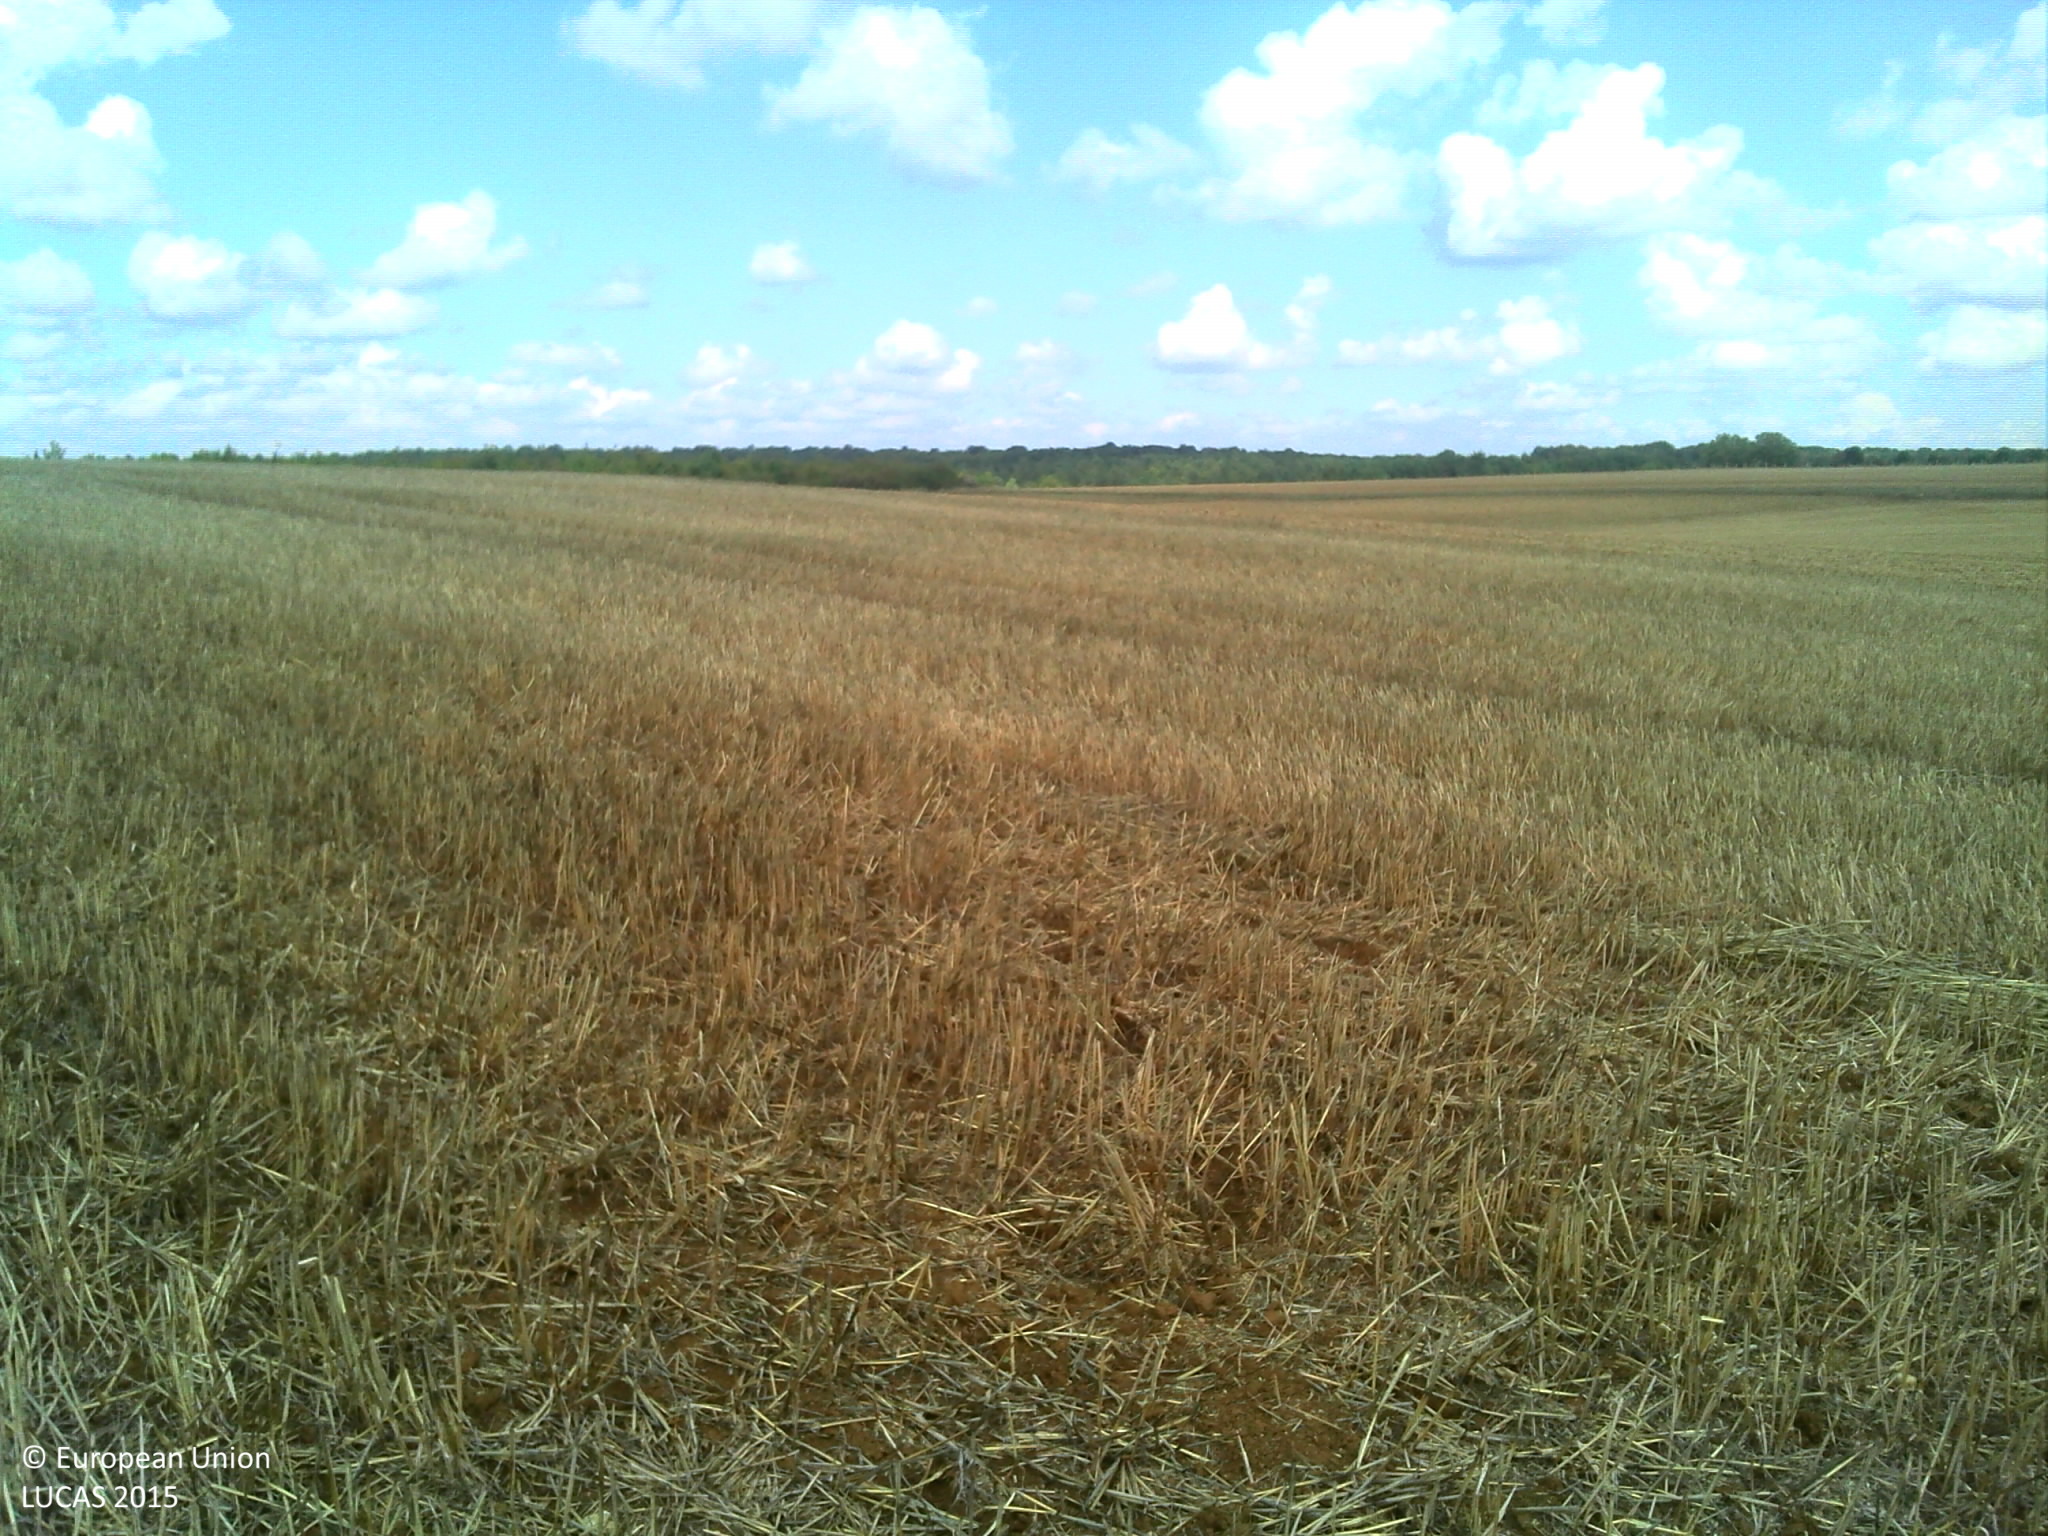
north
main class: Cropland
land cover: Common wheat
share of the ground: 10 - 25 %
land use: Agriculture (excluding fallow land and kitchen gardens)
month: September
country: FR
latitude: 48.8009
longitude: 6.0379
